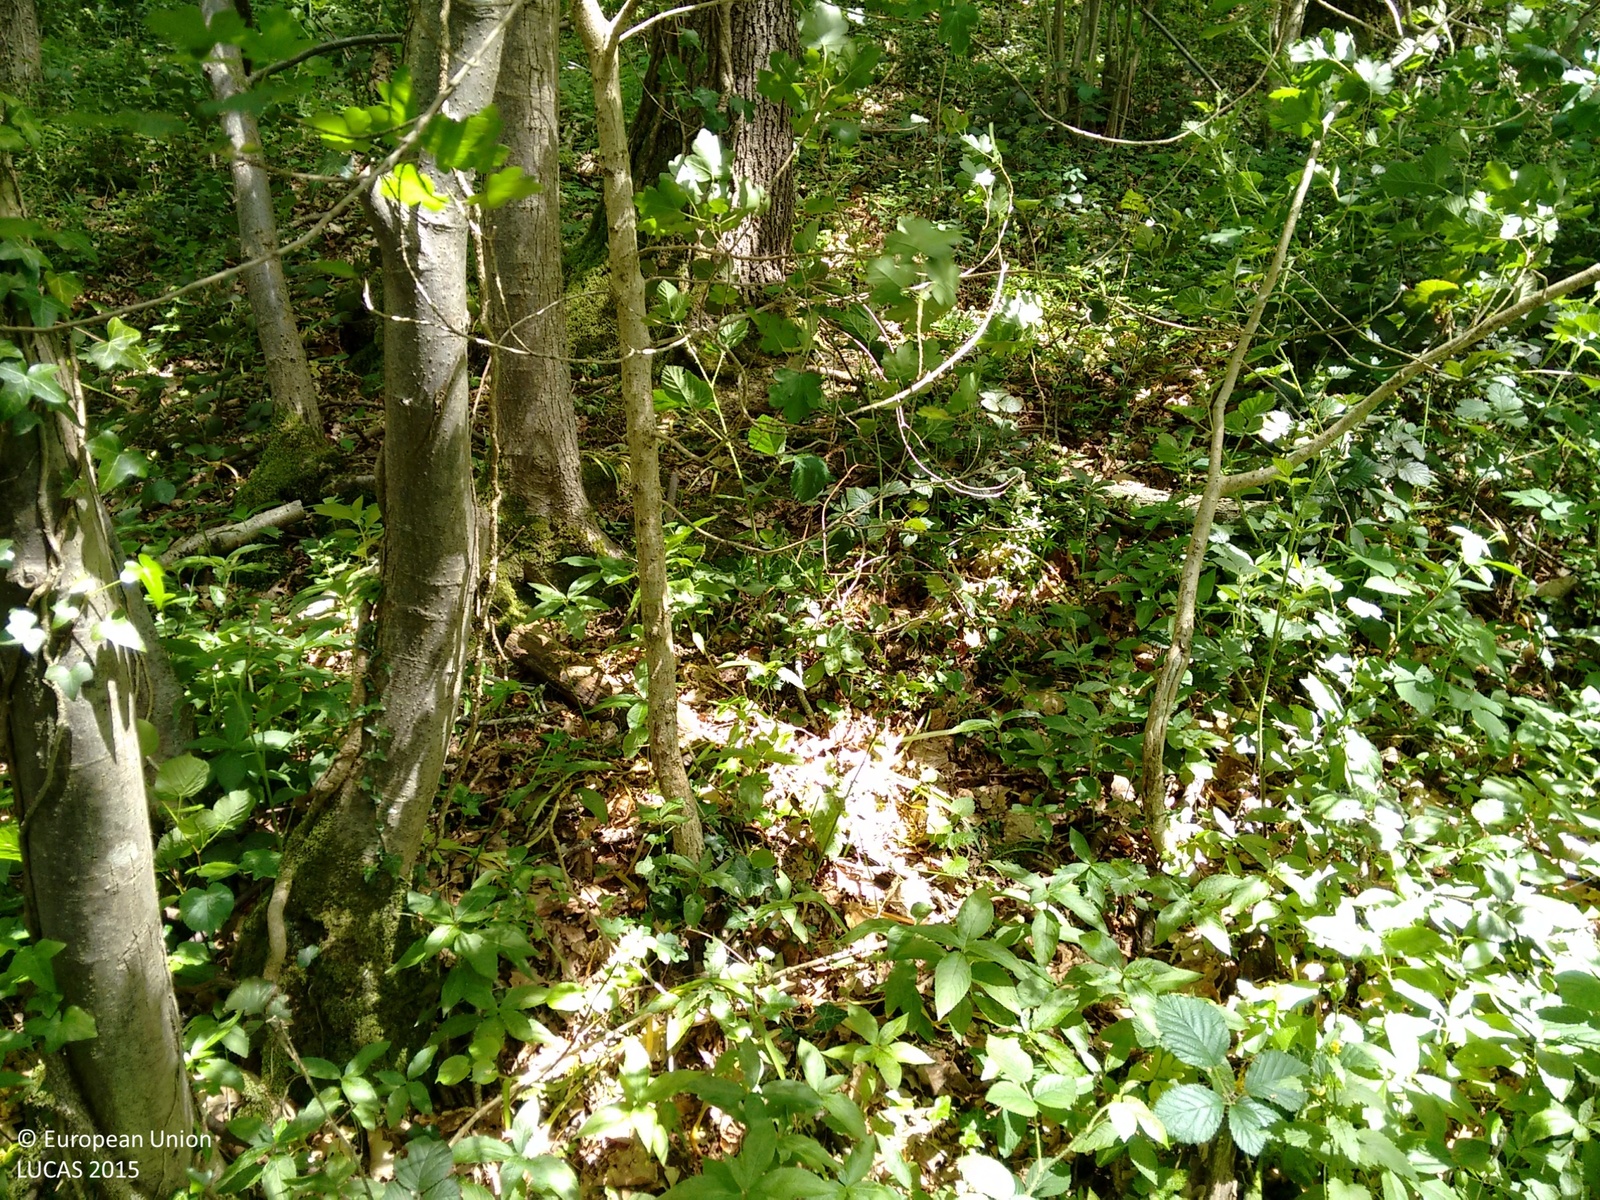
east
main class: Woodland
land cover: Broadleaved woodland
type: mesophytic deciduous forest
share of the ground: > 75 %
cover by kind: broadleaved forest trees 100 %
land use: Semi-natural and natural areas not in use
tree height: > 5 m
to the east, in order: Broadleaved woodland; Tracks; Broadleaved woodland; Ditches and canals; Broadleaved woodland
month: June
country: GB
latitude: 52.1445
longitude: -2.3833
